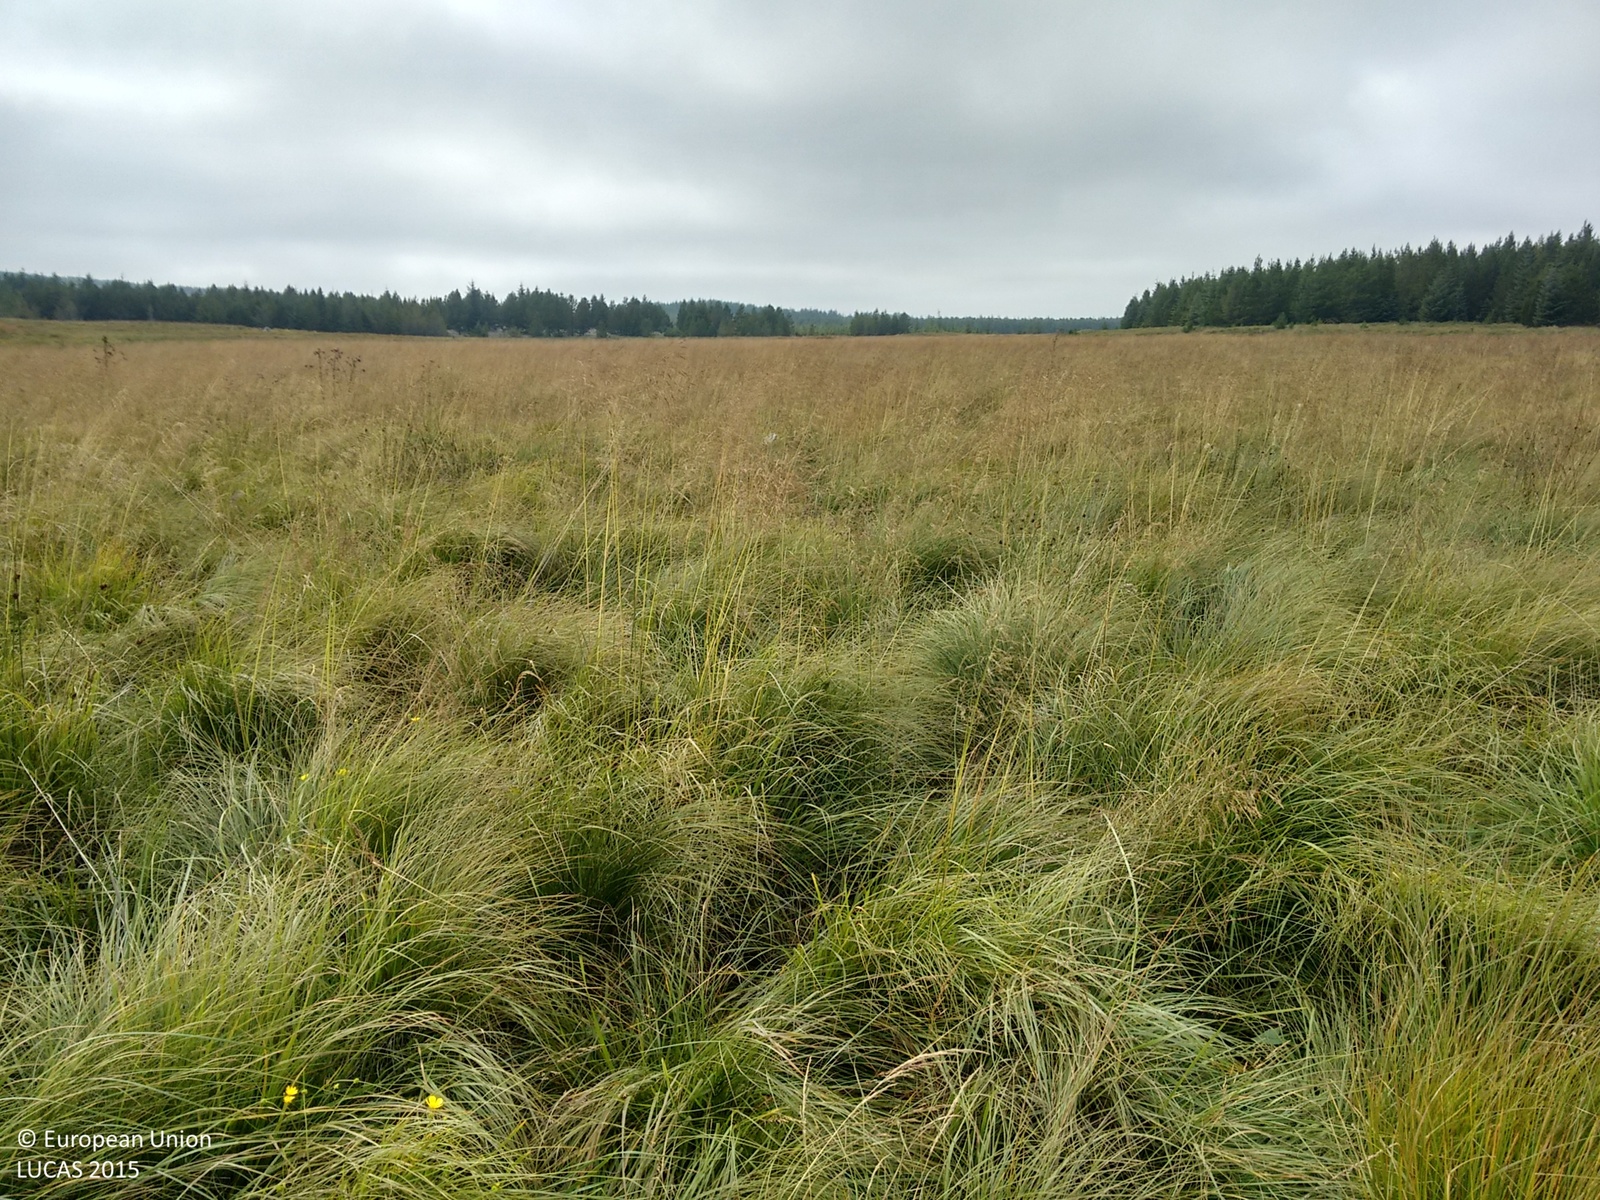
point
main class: Grassland
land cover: Grassland without tree/shrub cover
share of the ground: > 75 %
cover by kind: herbaceous plants 100 %
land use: Agriculture (excluding fallow land and kitchen gardens)
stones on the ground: < 10 %
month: September
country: GB
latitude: 58.0991
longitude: -4.3876
